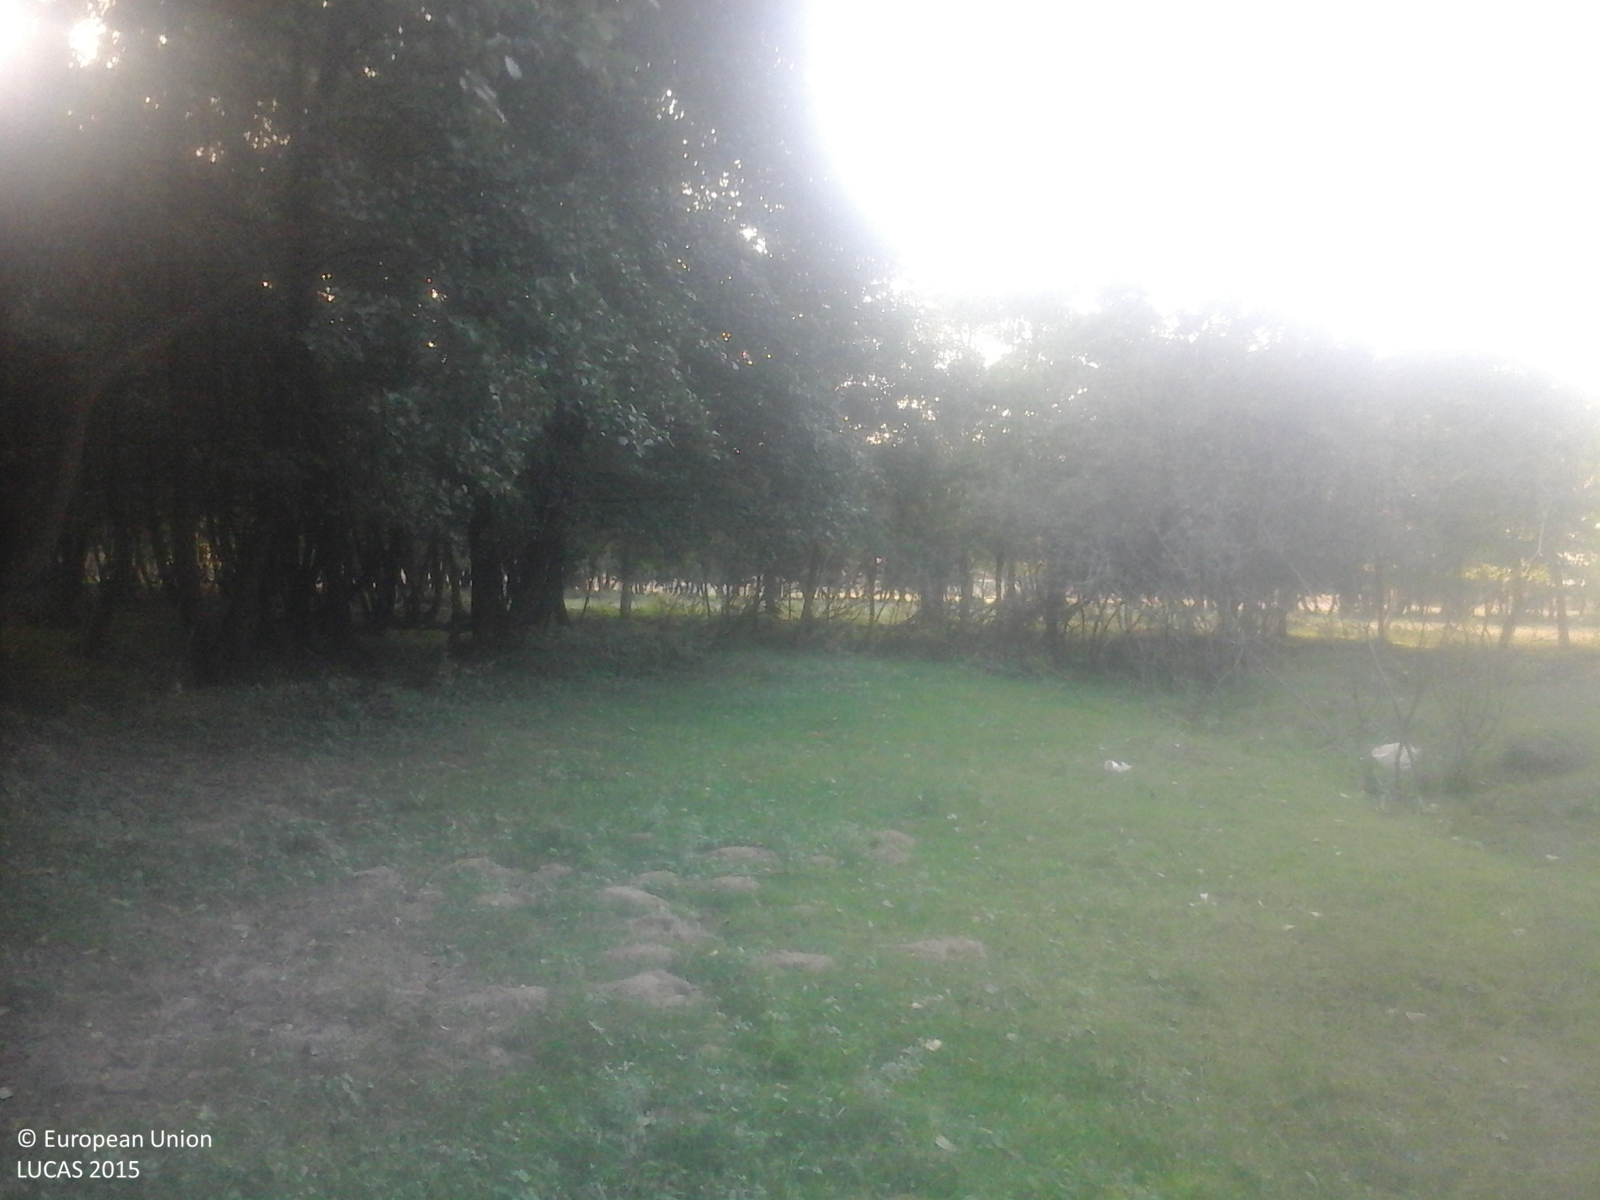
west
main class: Grassland
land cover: Grassland without tree/shrub cover
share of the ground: > 75 %
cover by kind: herbaceous plants 100 %
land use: Agriculture (excluding fallow land and kitchen gardens)
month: September
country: RO
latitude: 46.6259
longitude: 22.4192
